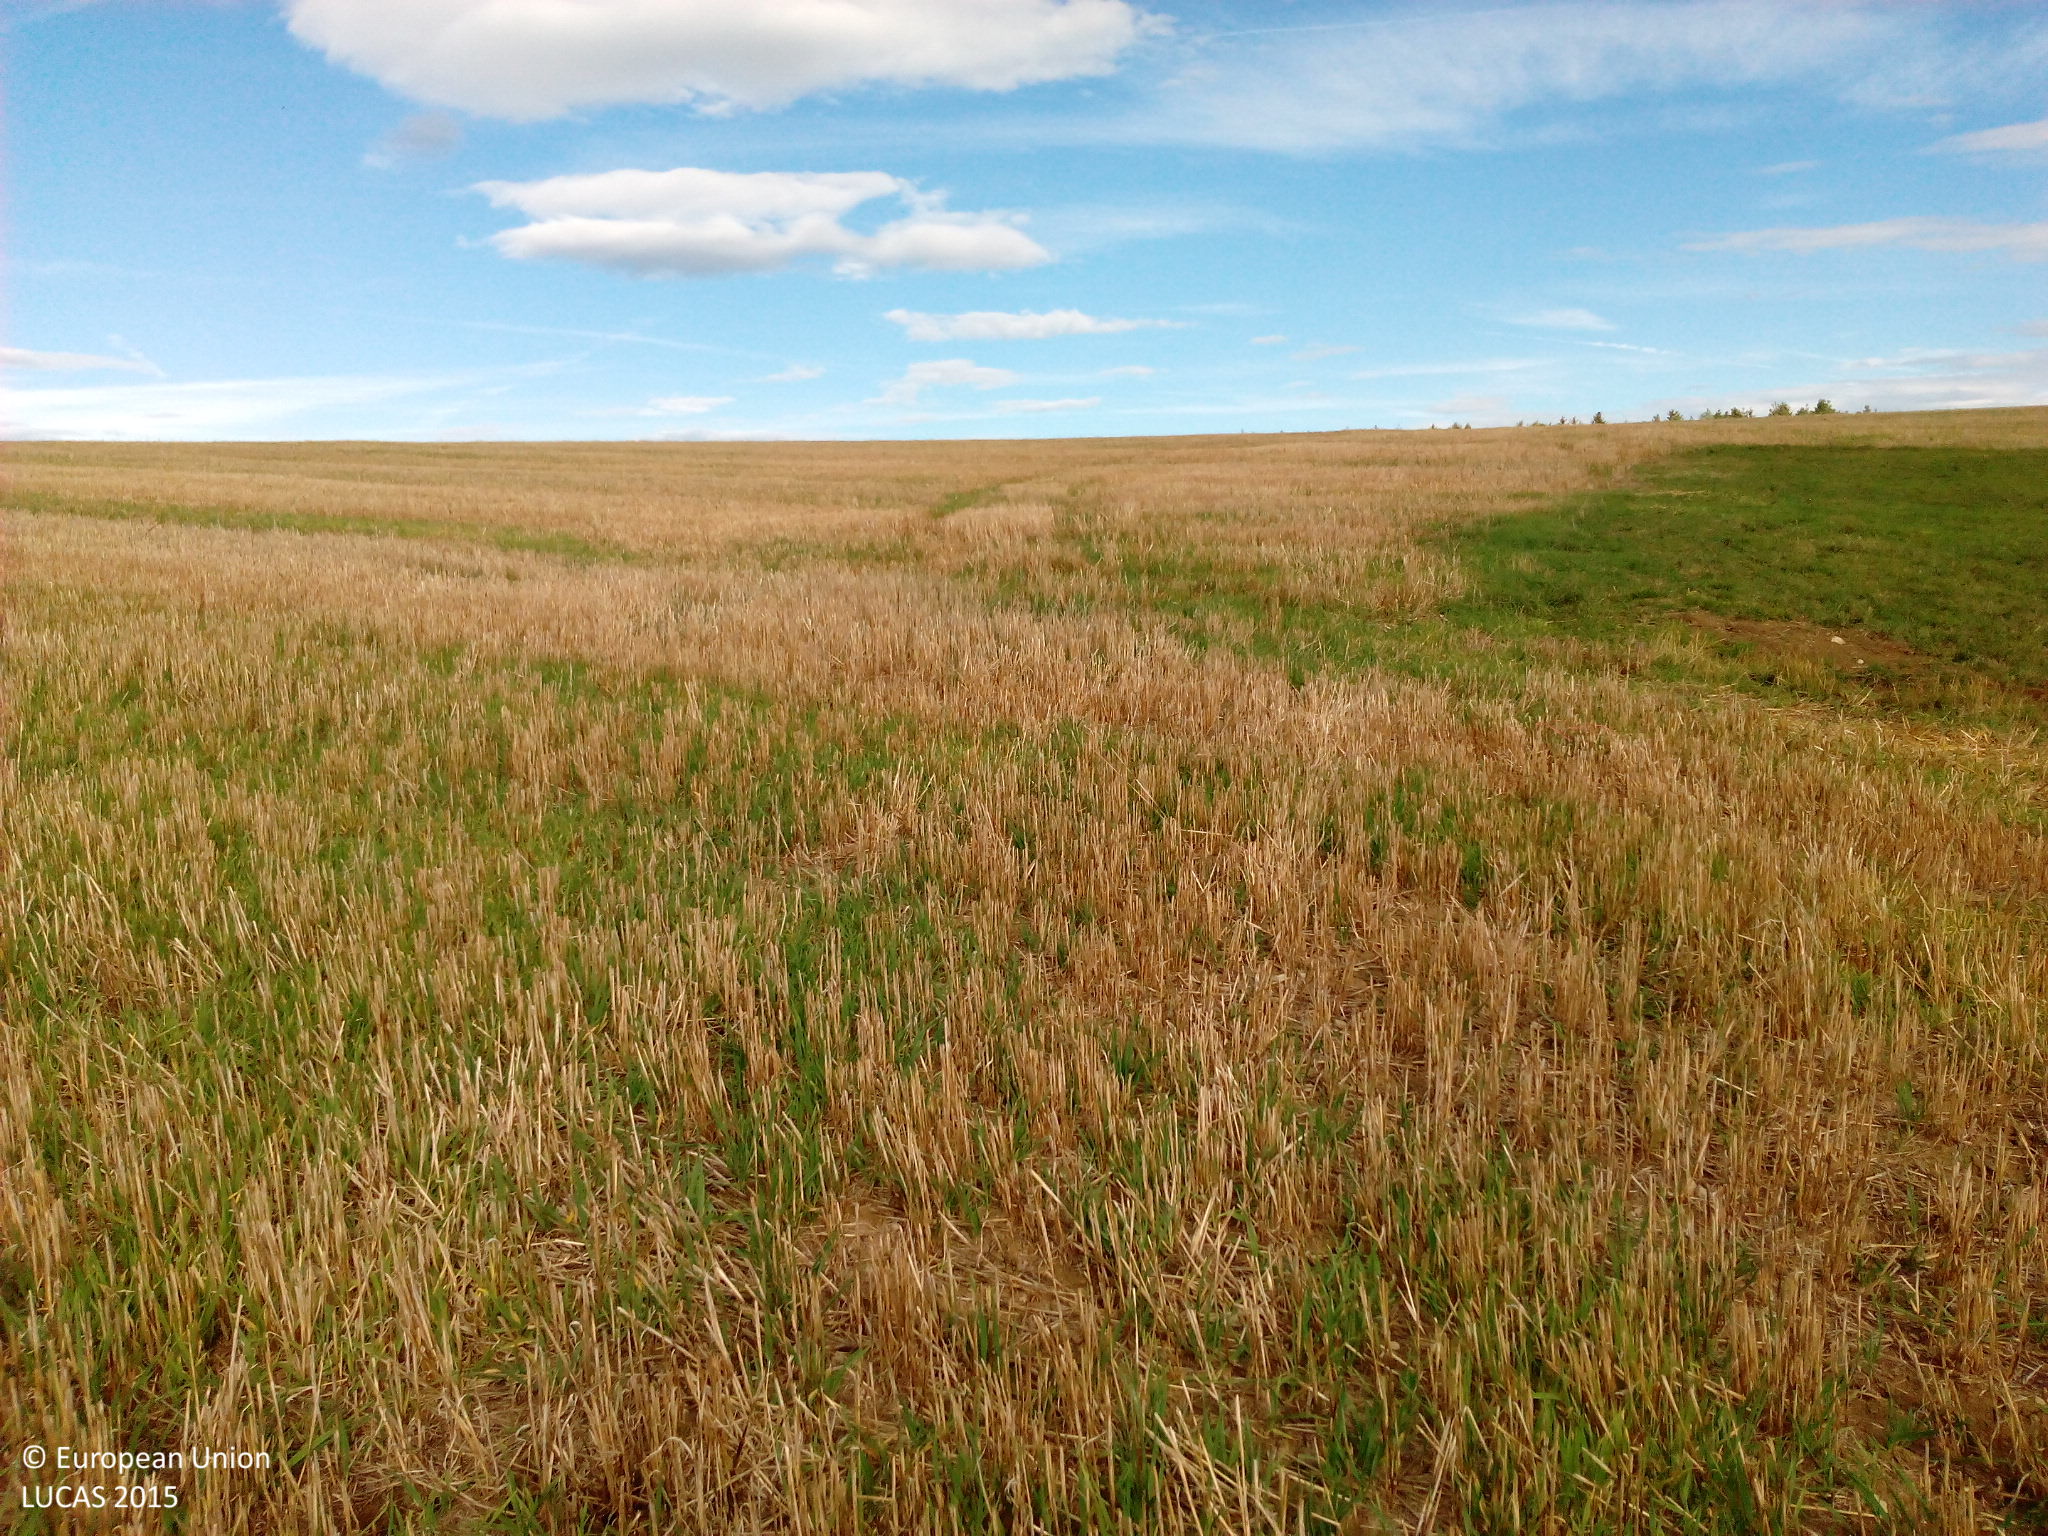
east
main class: Cropland
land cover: Common wheat
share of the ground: 10 - 25 %
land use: Agriculture (excluding fallow land and kitchen gardens)
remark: Harvested field
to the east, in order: Common wheat
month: September
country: DE
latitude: 48.1981
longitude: 8.7226
